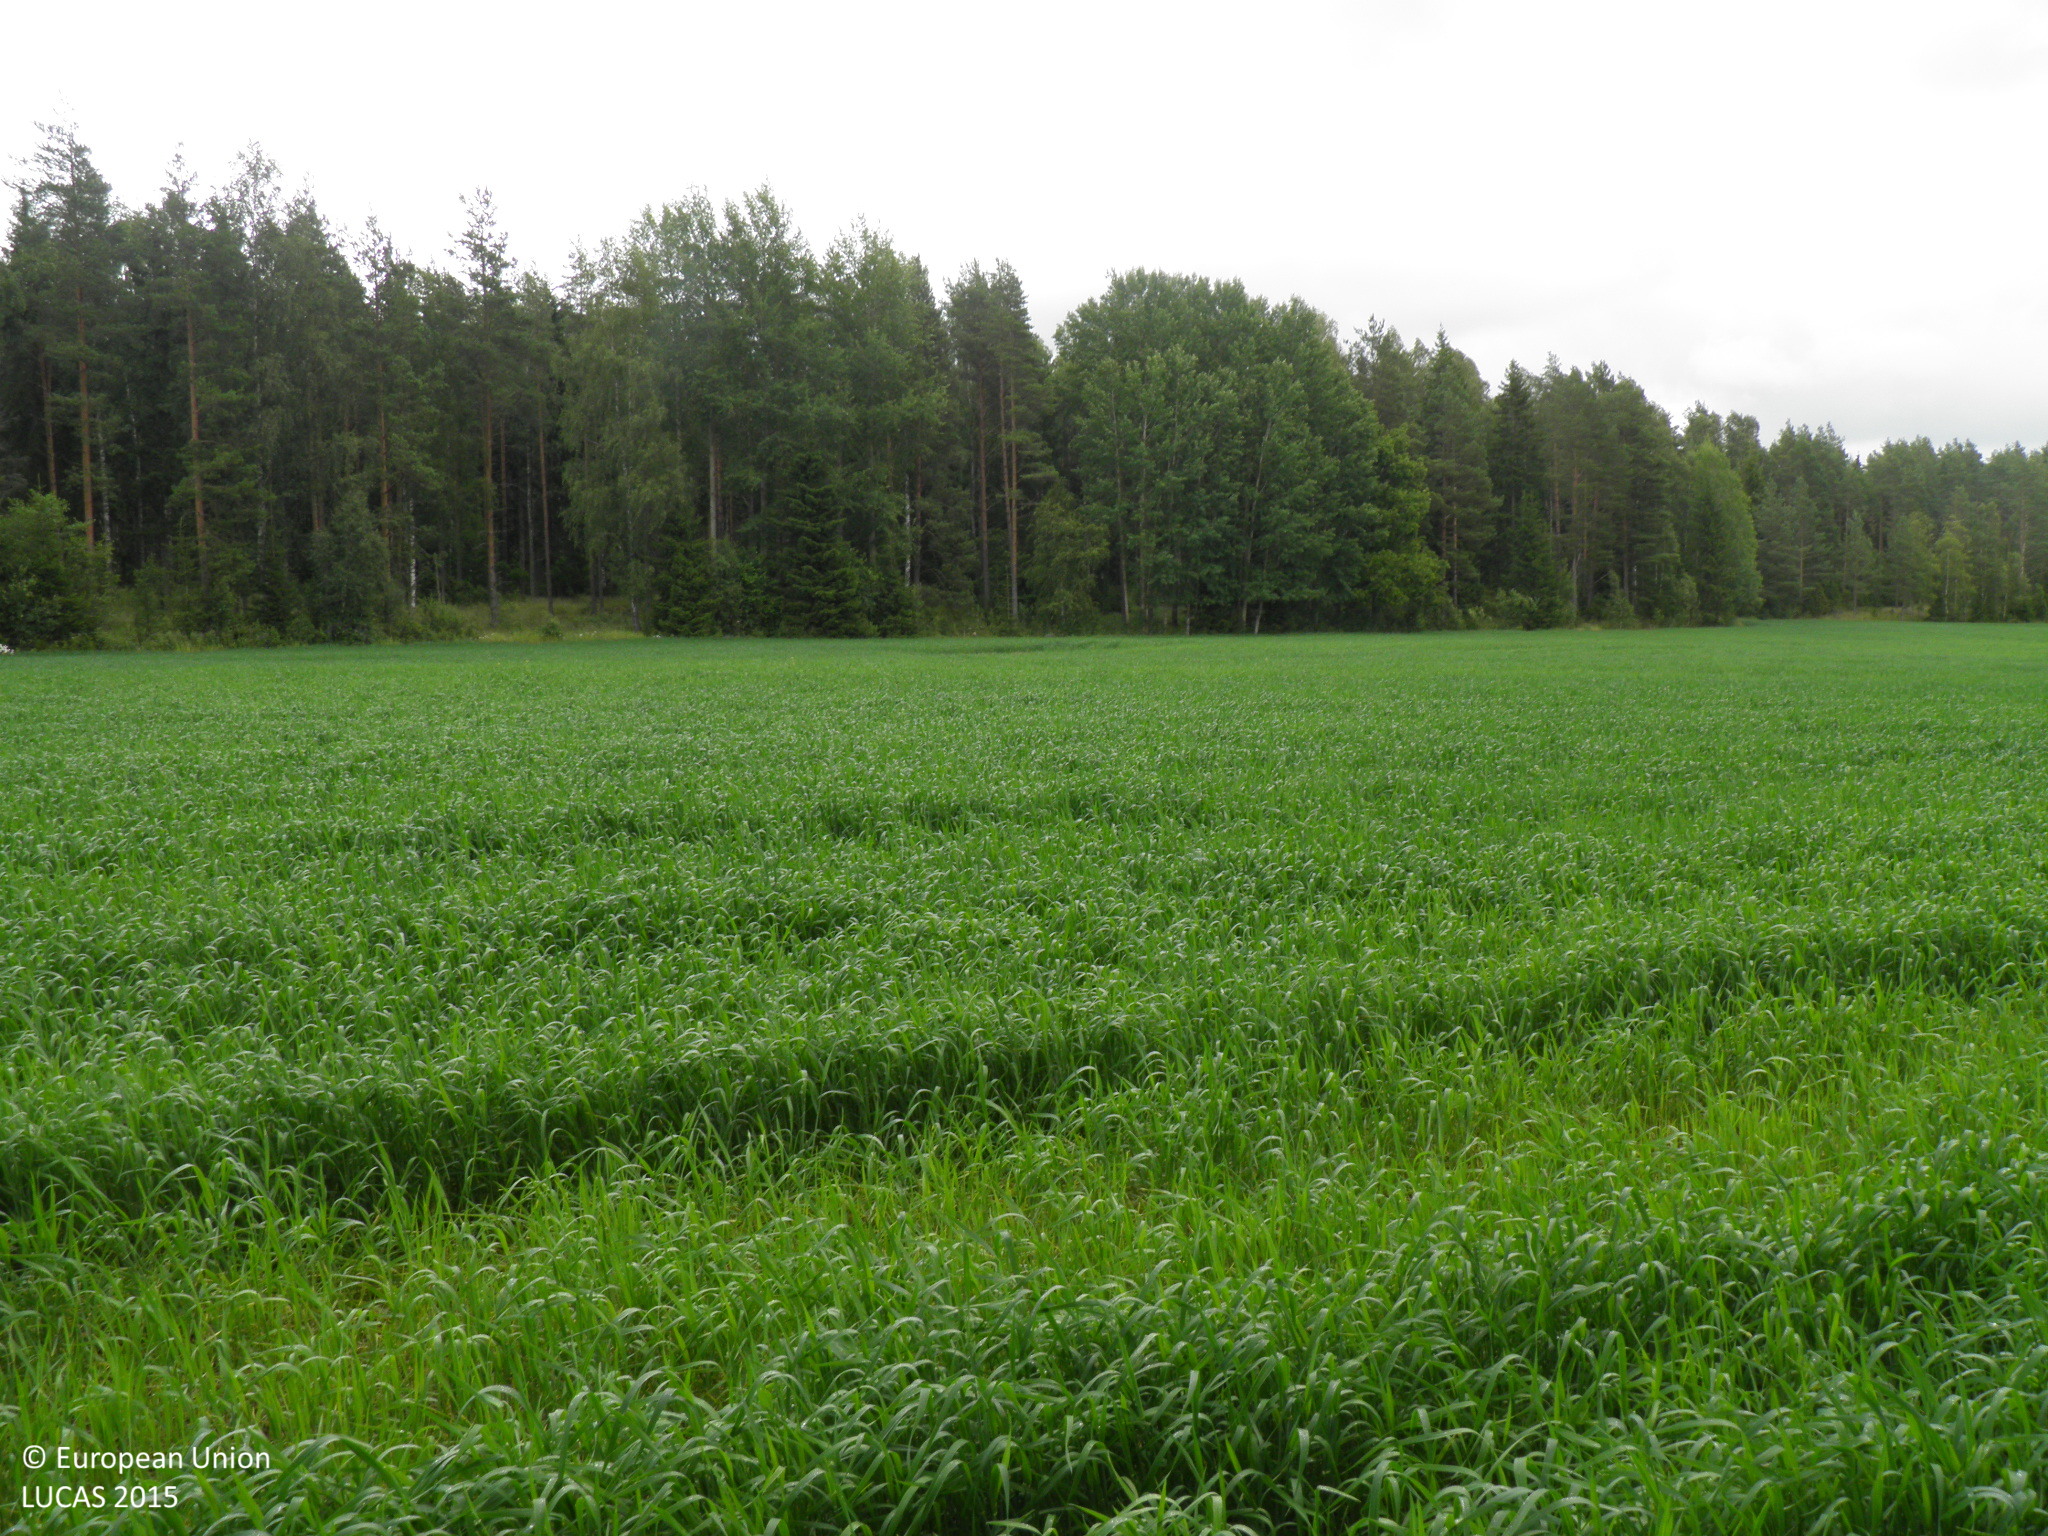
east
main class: Cropland
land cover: Common wheat
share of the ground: > 75 %
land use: Agriculture (excluding fallow land and kitchen gardens)
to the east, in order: Common wheat; Ditches and canals; Pine dominated mixed woodland; Spruce dominated mixed woodland; Pine dominated mixed woodland
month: July
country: FI
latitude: 60.6571
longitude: 21.4894
